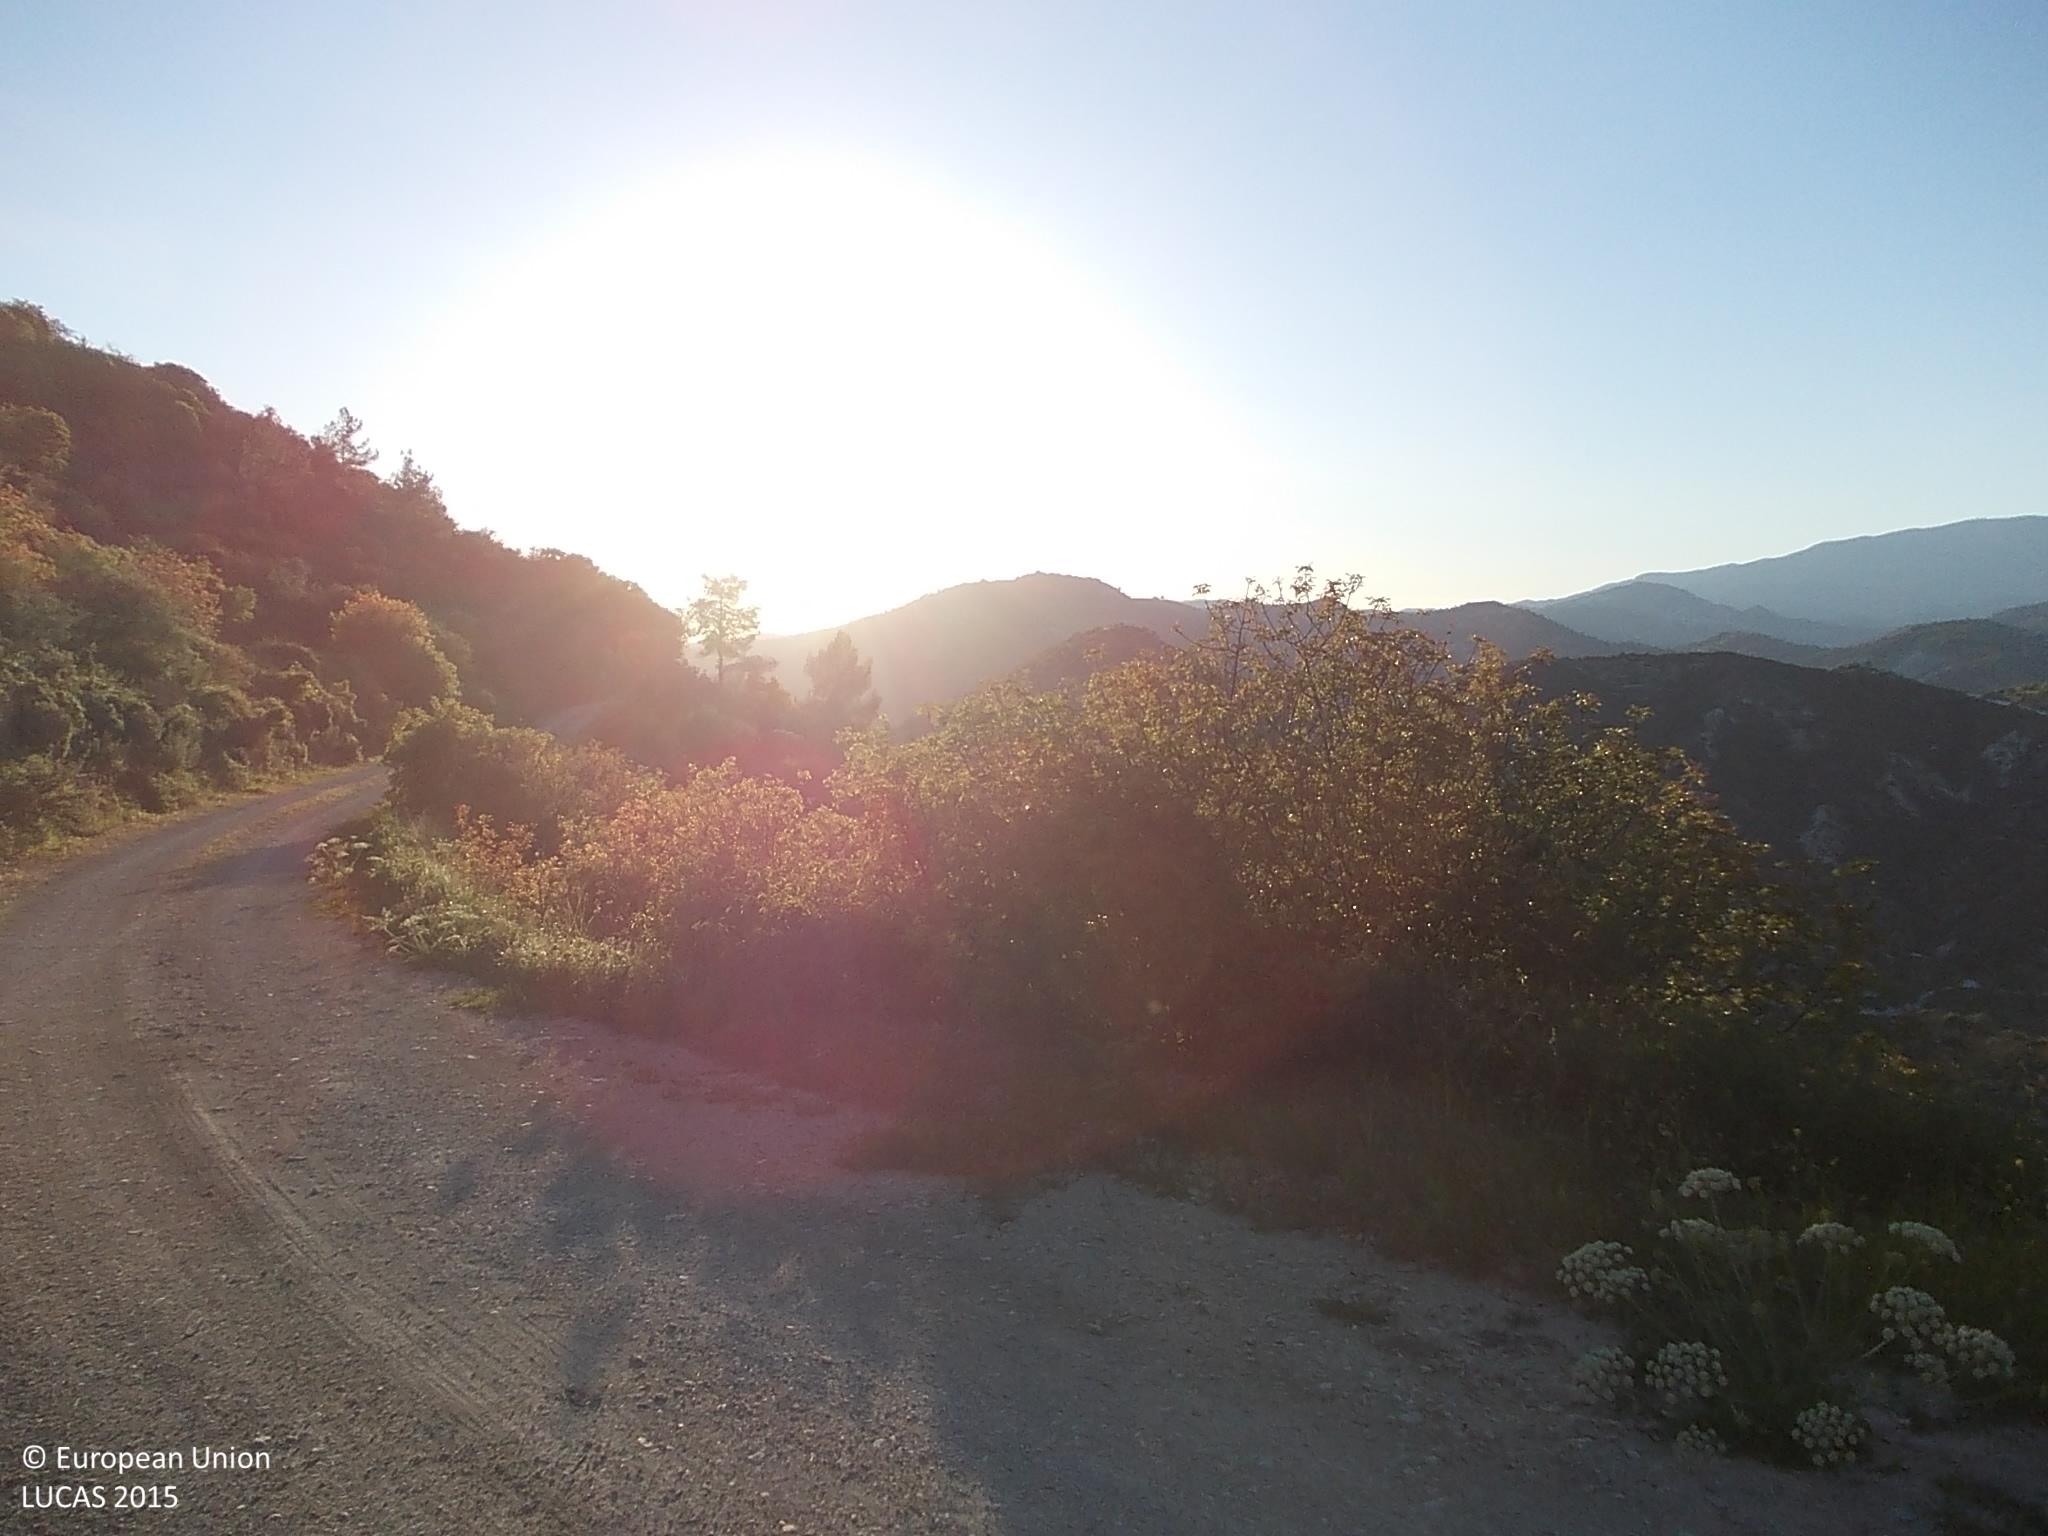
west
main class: Woodland
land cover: Pine dominated coniferous woodland
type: coniferous forest of the mediterranean region
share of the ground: 10 - 25 %
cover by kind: shrubs 65 %, unconsolidated bare surface 20 %, coniferous forest trees 15 %
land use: Forestry
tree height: > 5 m
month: April
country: CY
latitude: 34.7890
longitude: 33.0196
